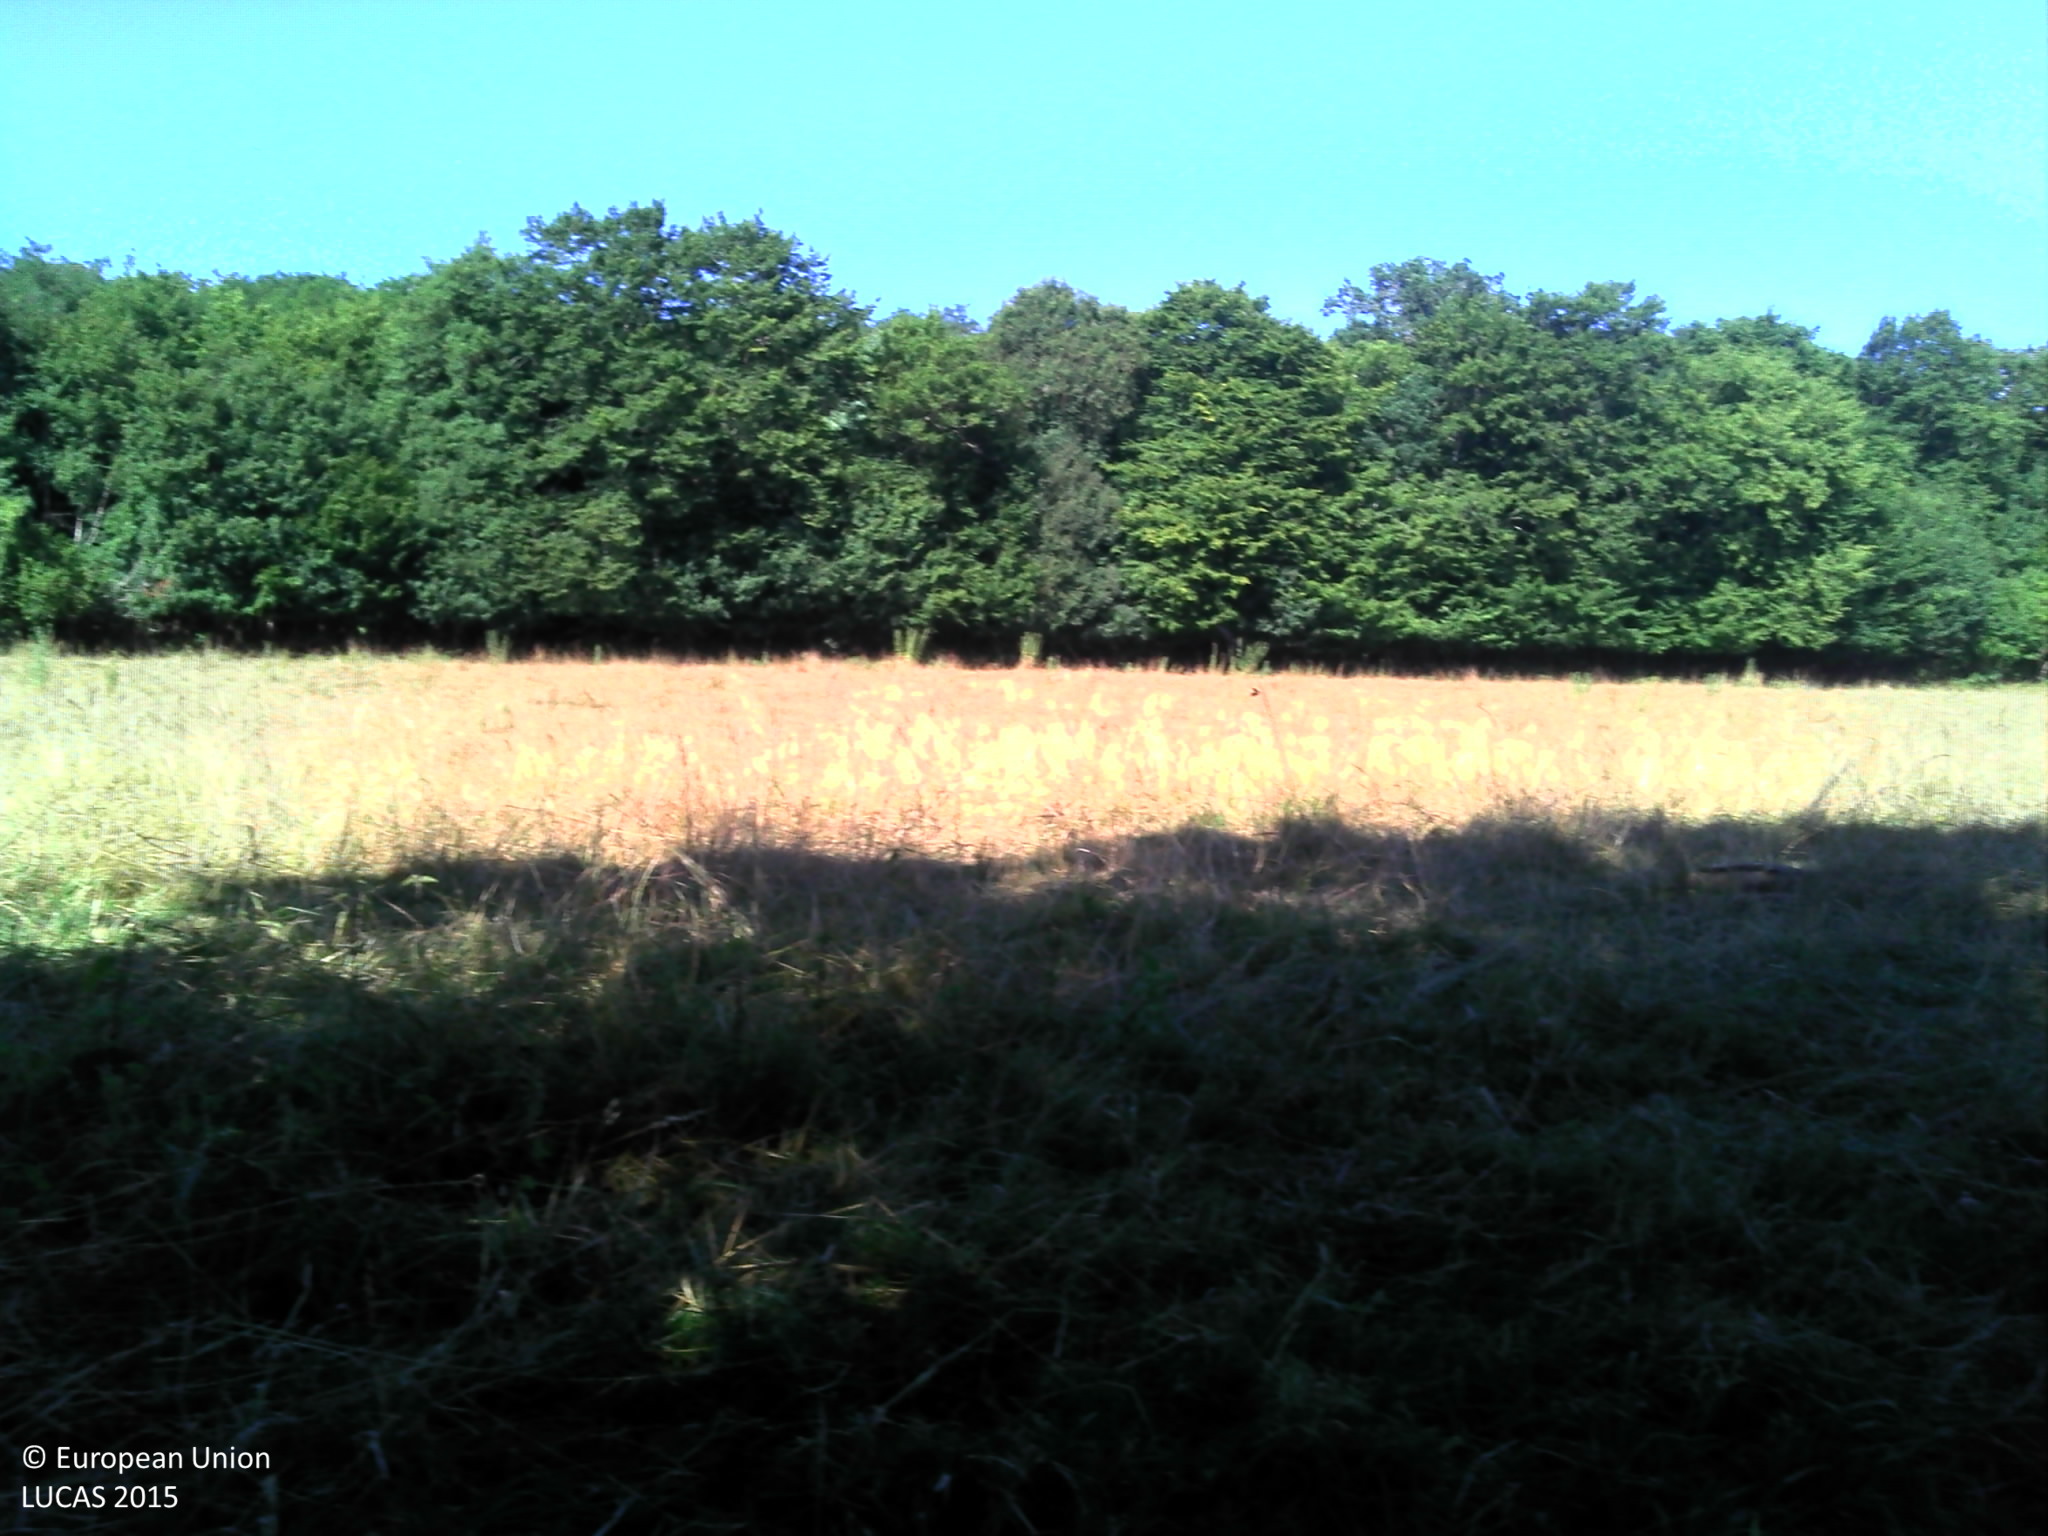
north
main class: Grassland
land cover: Grassland without tree/shrub cover
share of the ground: > 75 %
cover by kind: herbaceous plants 100 %
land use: Agriculture (excluding fallow land and kitchen gardens)
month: July
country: FR
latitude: 46.9900
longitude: 3.5944
